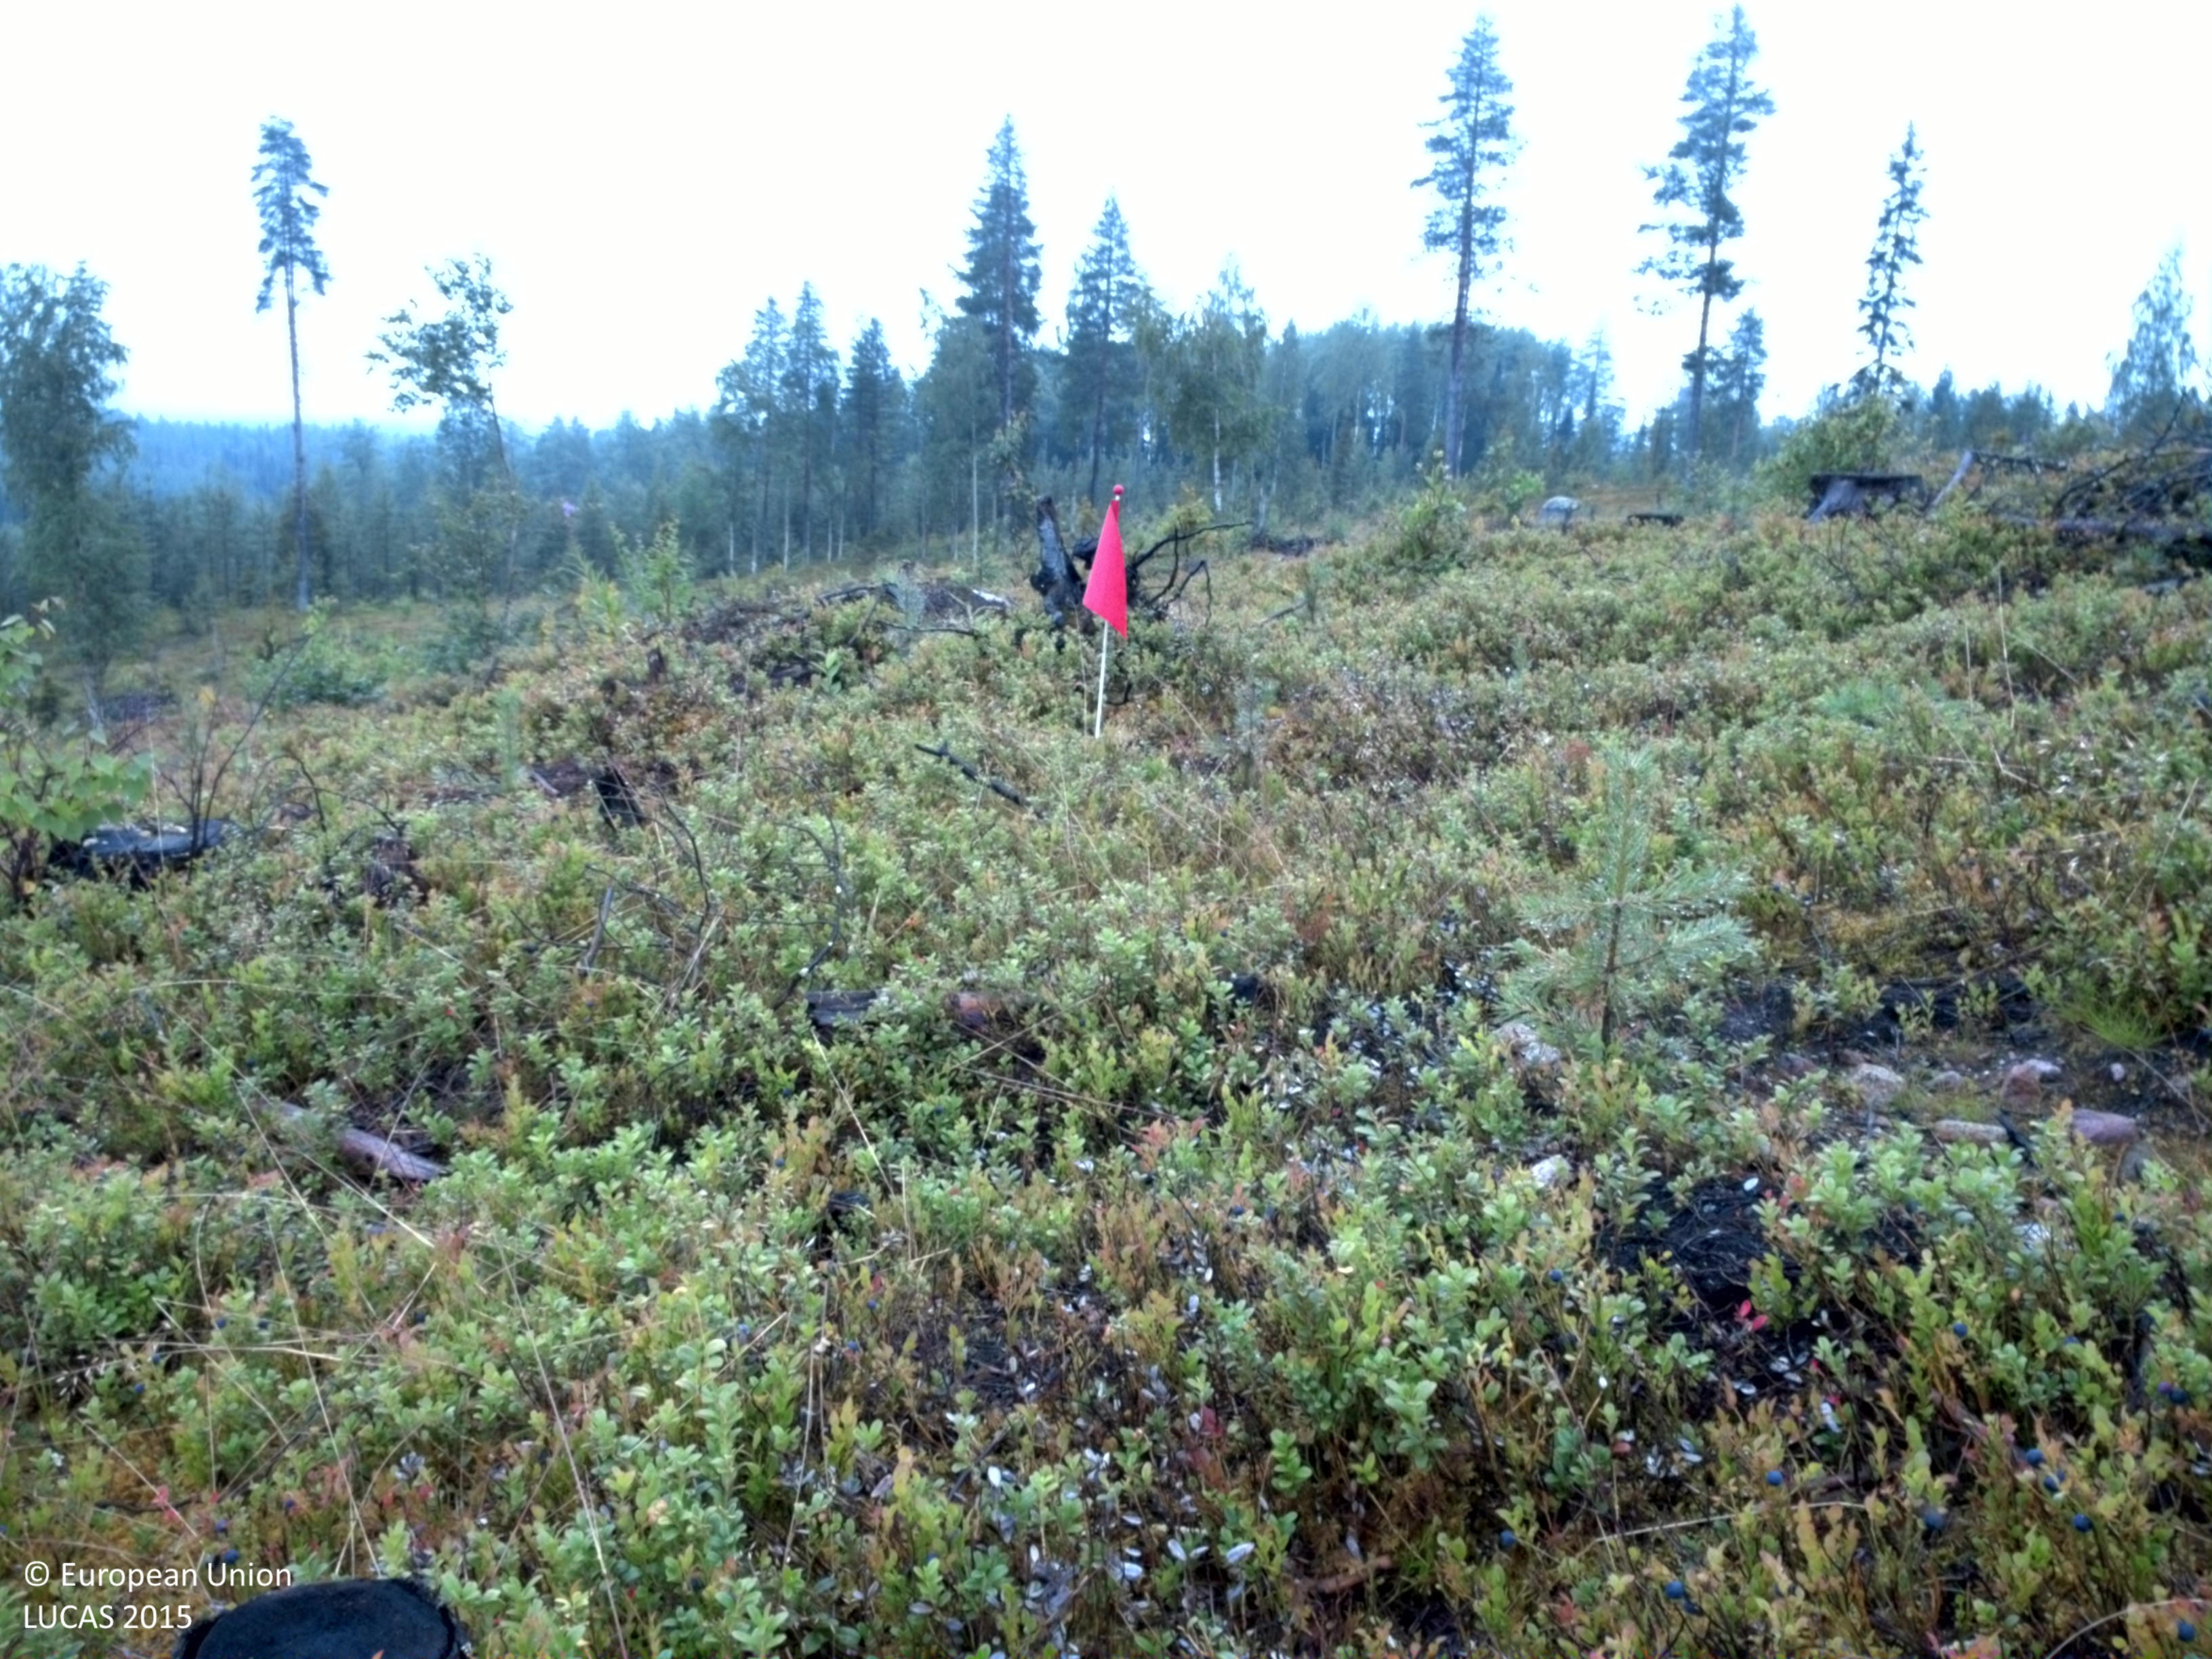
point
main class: Shrubland
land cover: Shrubland with sparse tree cover
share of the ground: > 75 %
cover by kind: shrubs 90 %, coniferous forest trees 5 %, unconsolidated bare surface 5 %
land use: Forestry
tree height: < 5 m
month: August
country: SE
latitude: 66.3494
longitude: 20.5245
